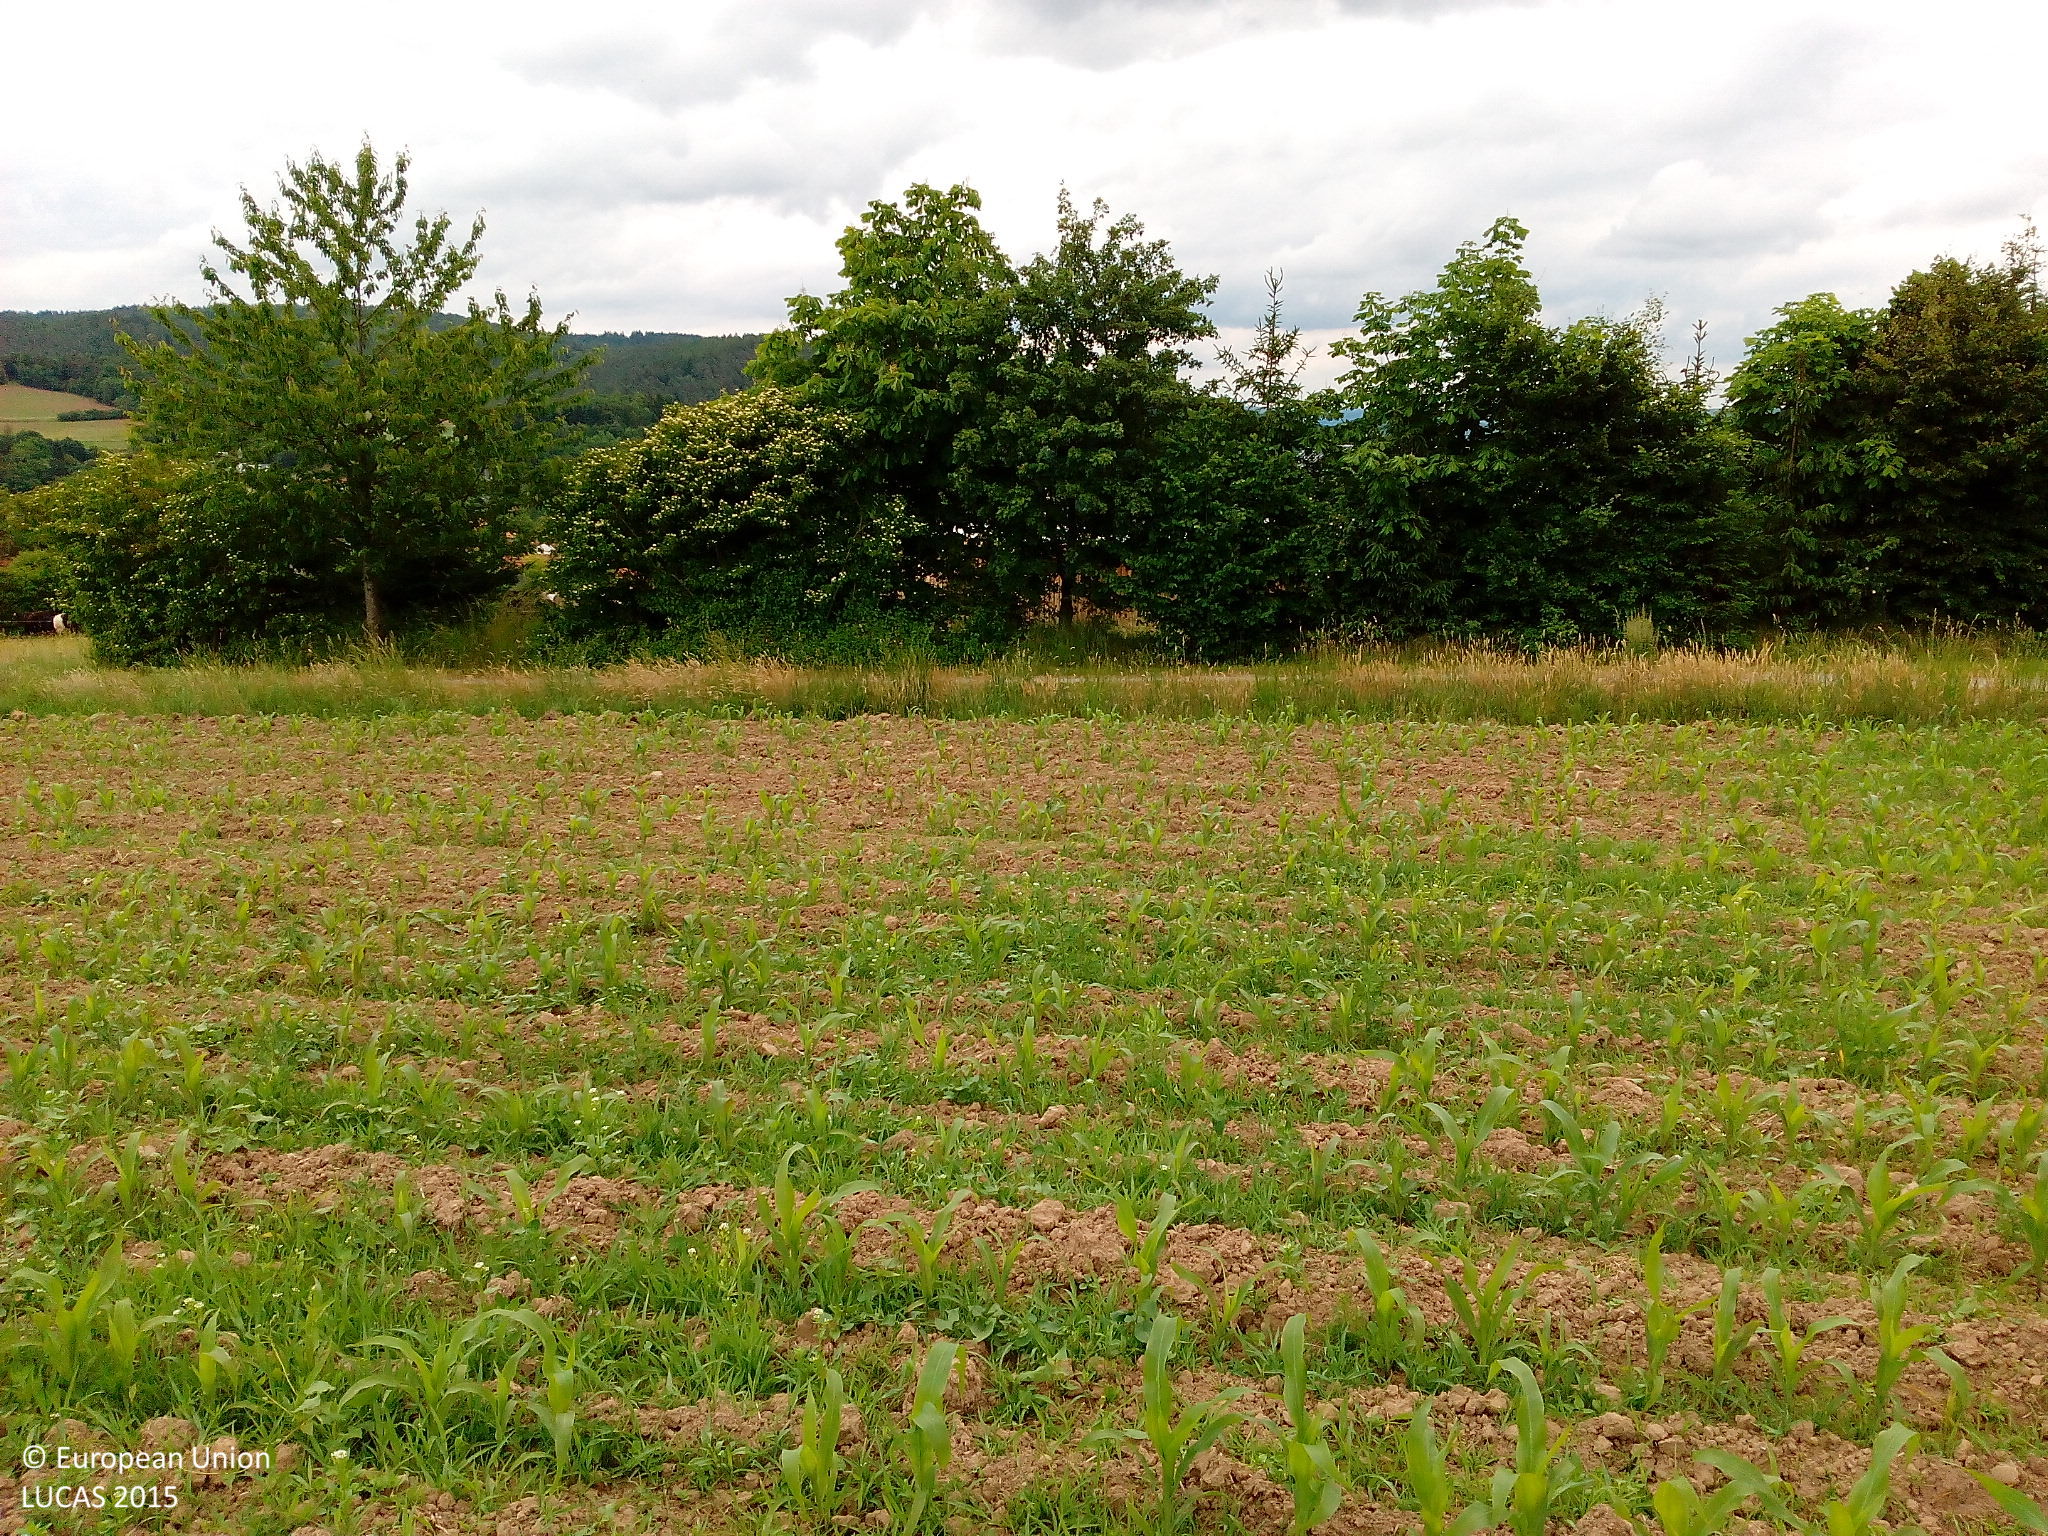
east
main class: Cropland
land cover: Maize
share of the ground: 25 - 50 %
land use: Agriculture (excluding fallow land and kitchen gardens)
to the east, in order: Maize; Grass margins; Artificial constructions in urban areas
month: June
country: DE
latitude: 50.9027
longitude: 9.5877
